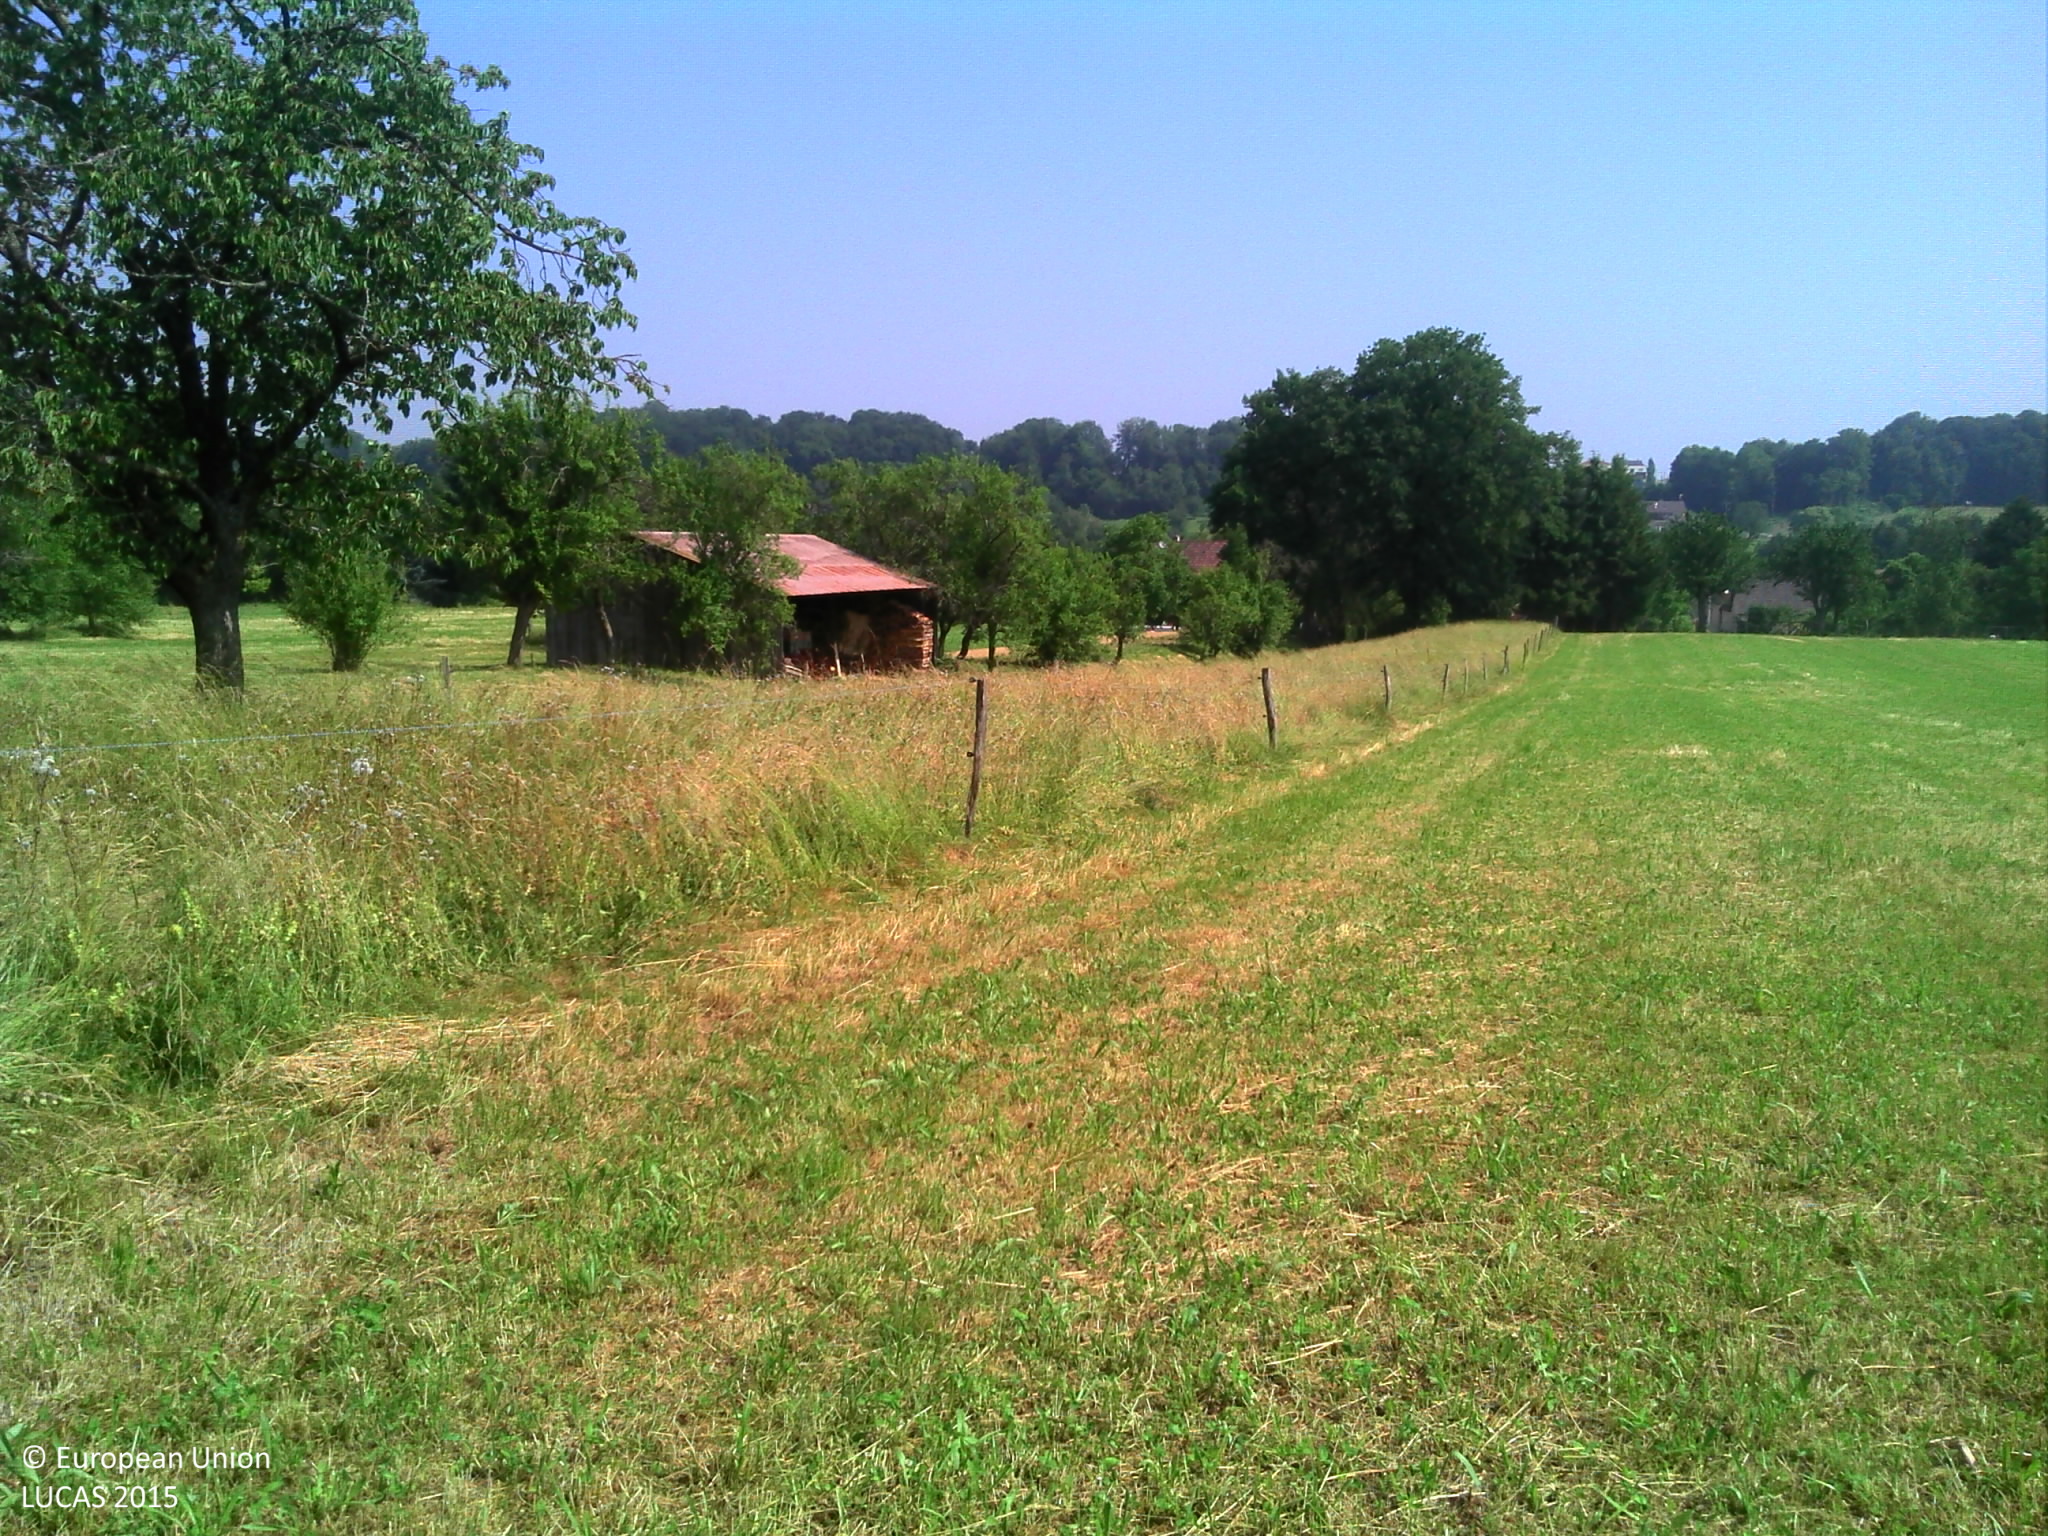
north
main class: Cropland
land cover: Apple fruit
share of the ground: 25 - 50 %
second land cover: Grassland without tree/shrub cover
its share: > 75 %
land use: Agriculture (excluding fallow land and kitchen gardens)
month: June
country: FR
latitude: 47.5443
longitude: 7.3842
